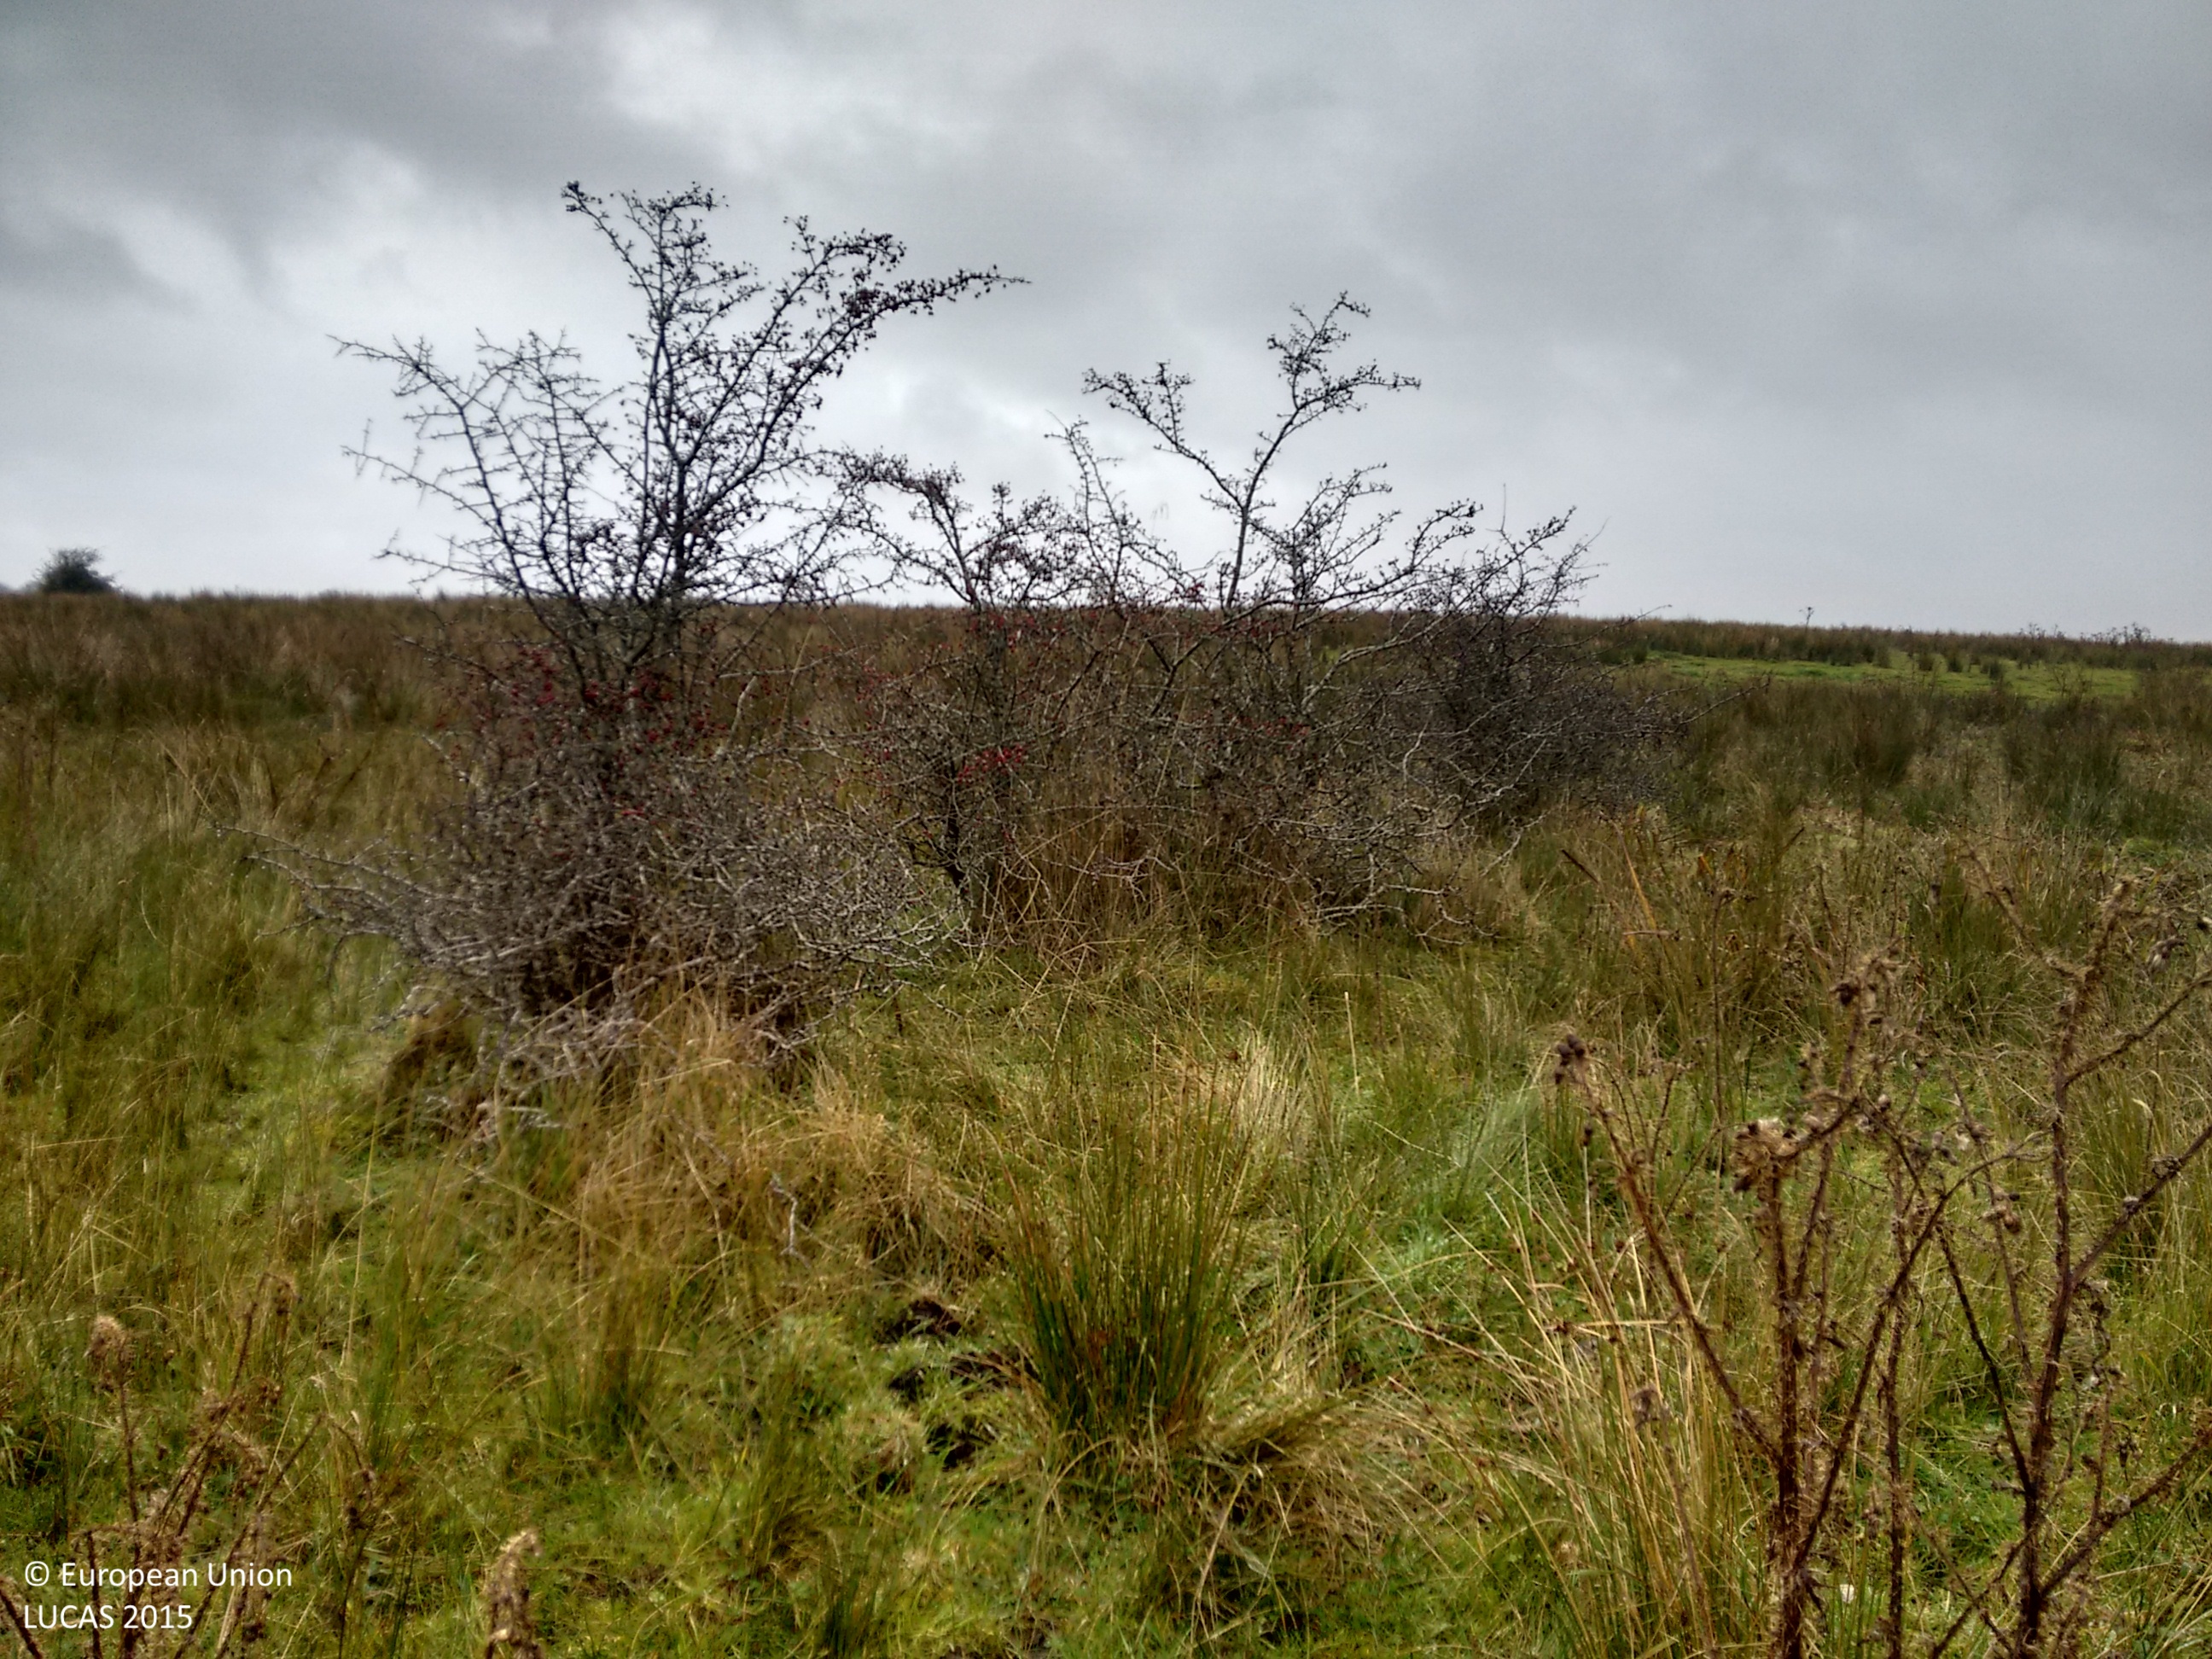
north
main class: Grassland
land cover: Grassland without tree/shrub cover
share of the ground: > 75 %
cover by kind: herbaceous plants 95 %, shrubs 5 %
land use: Agriculture (excluding fallow land and kitchen gardens)
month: October
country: IE
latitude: 53.8961
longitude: -8.1520
